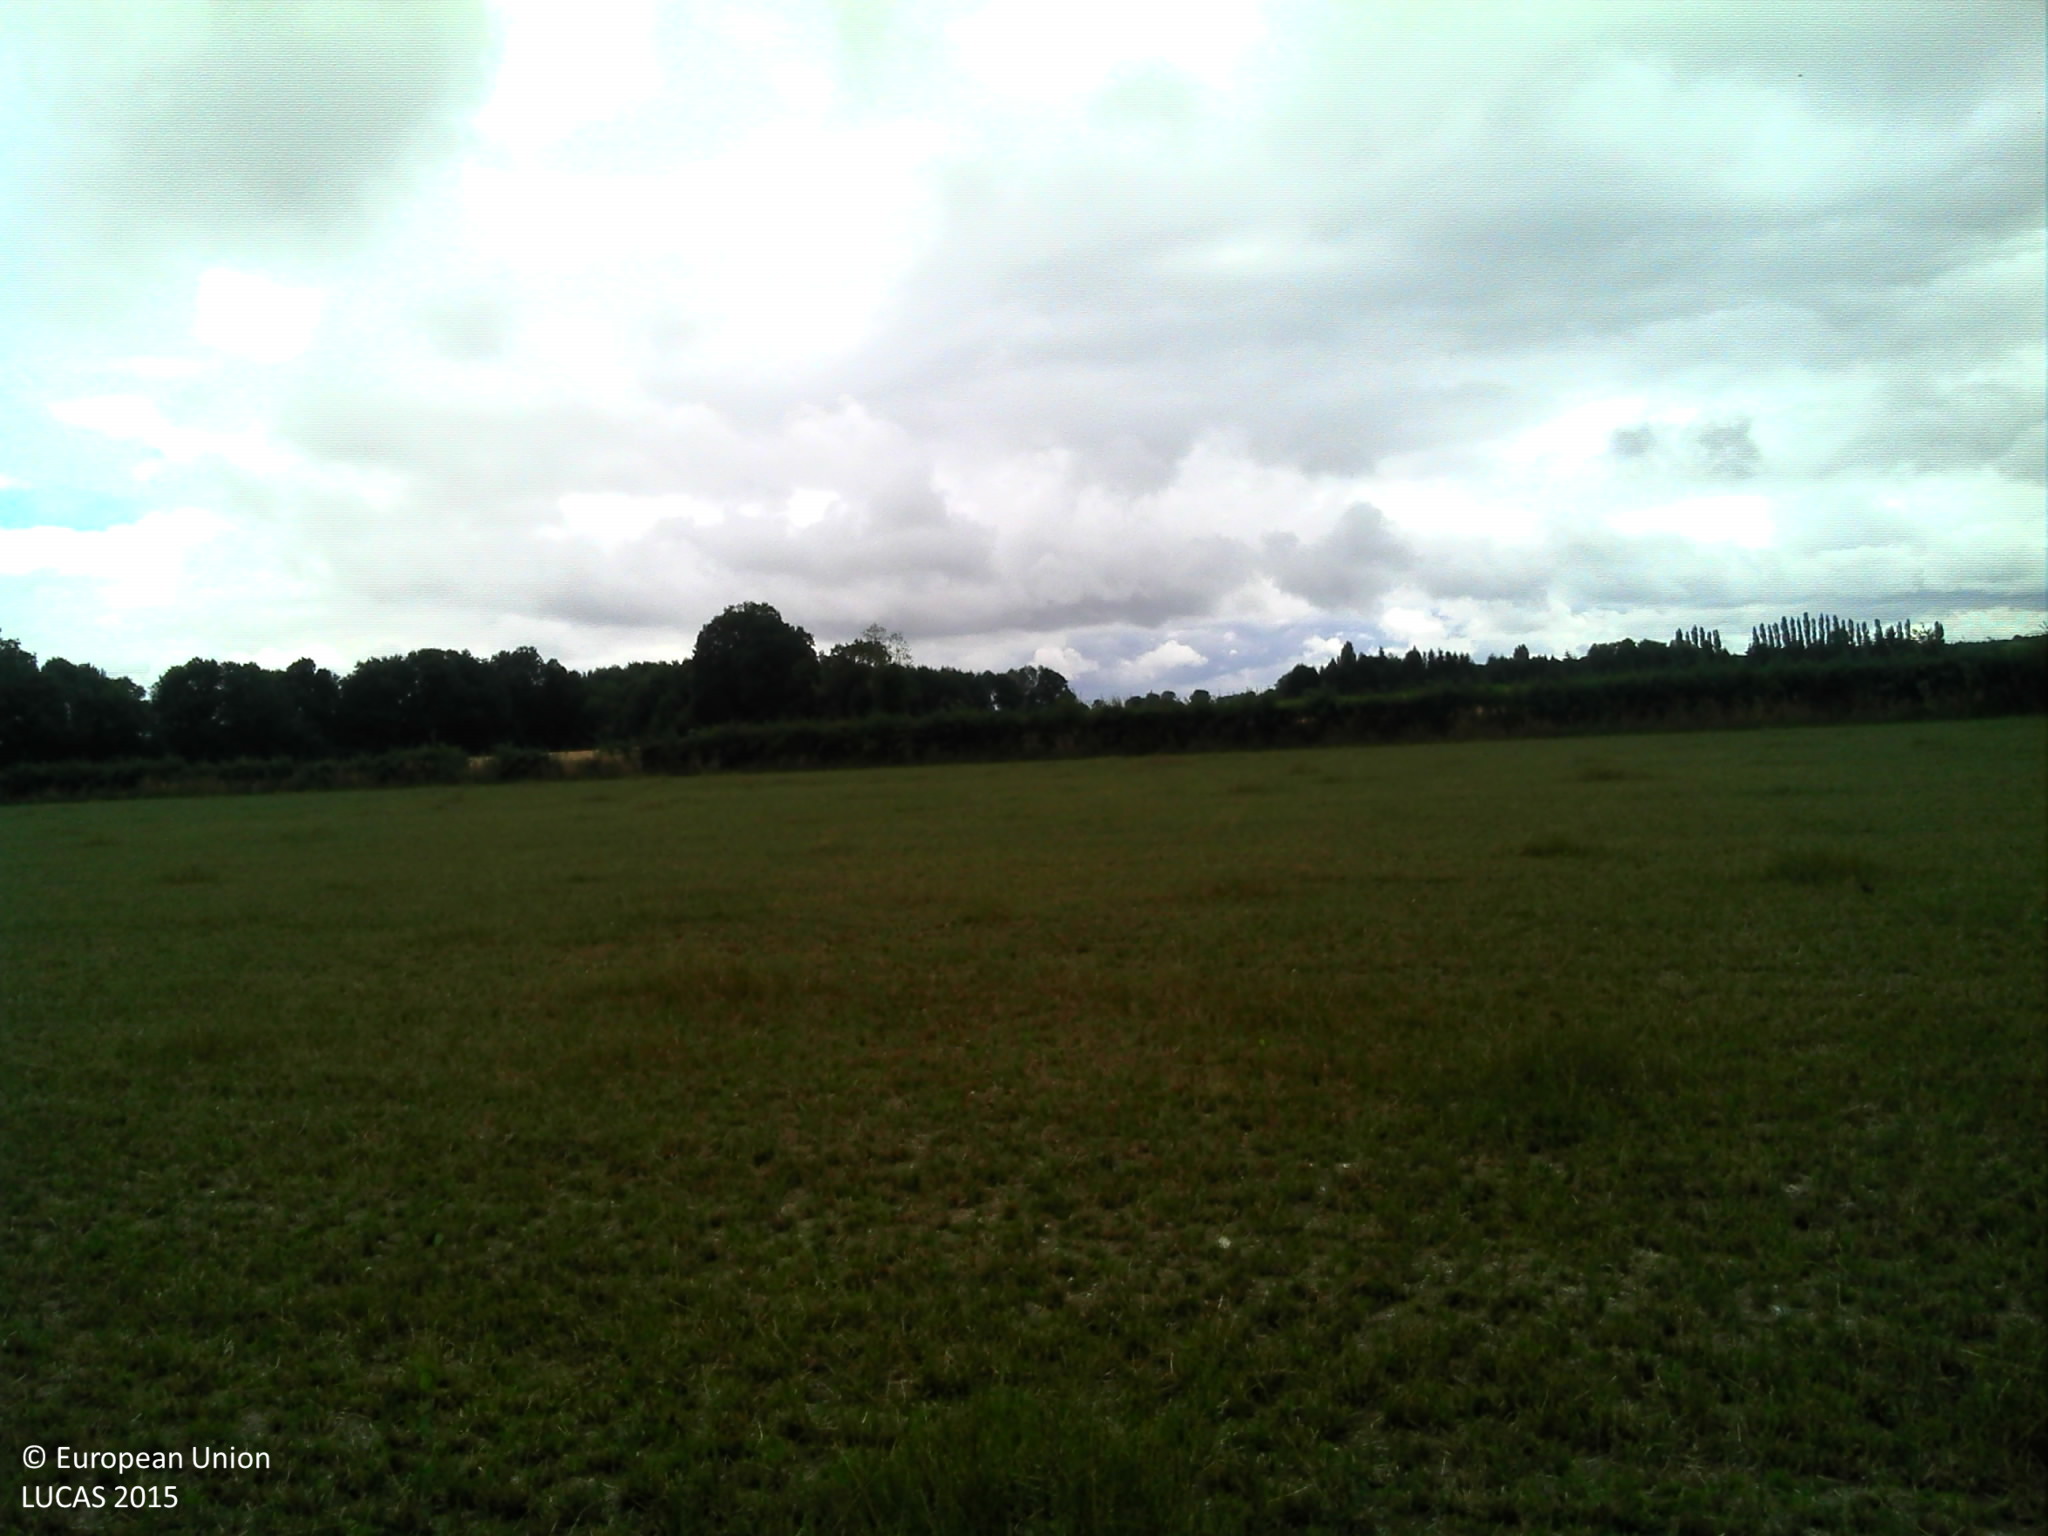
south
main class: Grassland
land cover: Grassland without tree/shrub cover
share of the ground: > 75 %
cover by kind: herbaceous plants 100 %
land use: Agriculture (excluding fallow land and kitchen gardens)
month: July
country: FR
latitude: 48.8477
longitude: 0.5310
